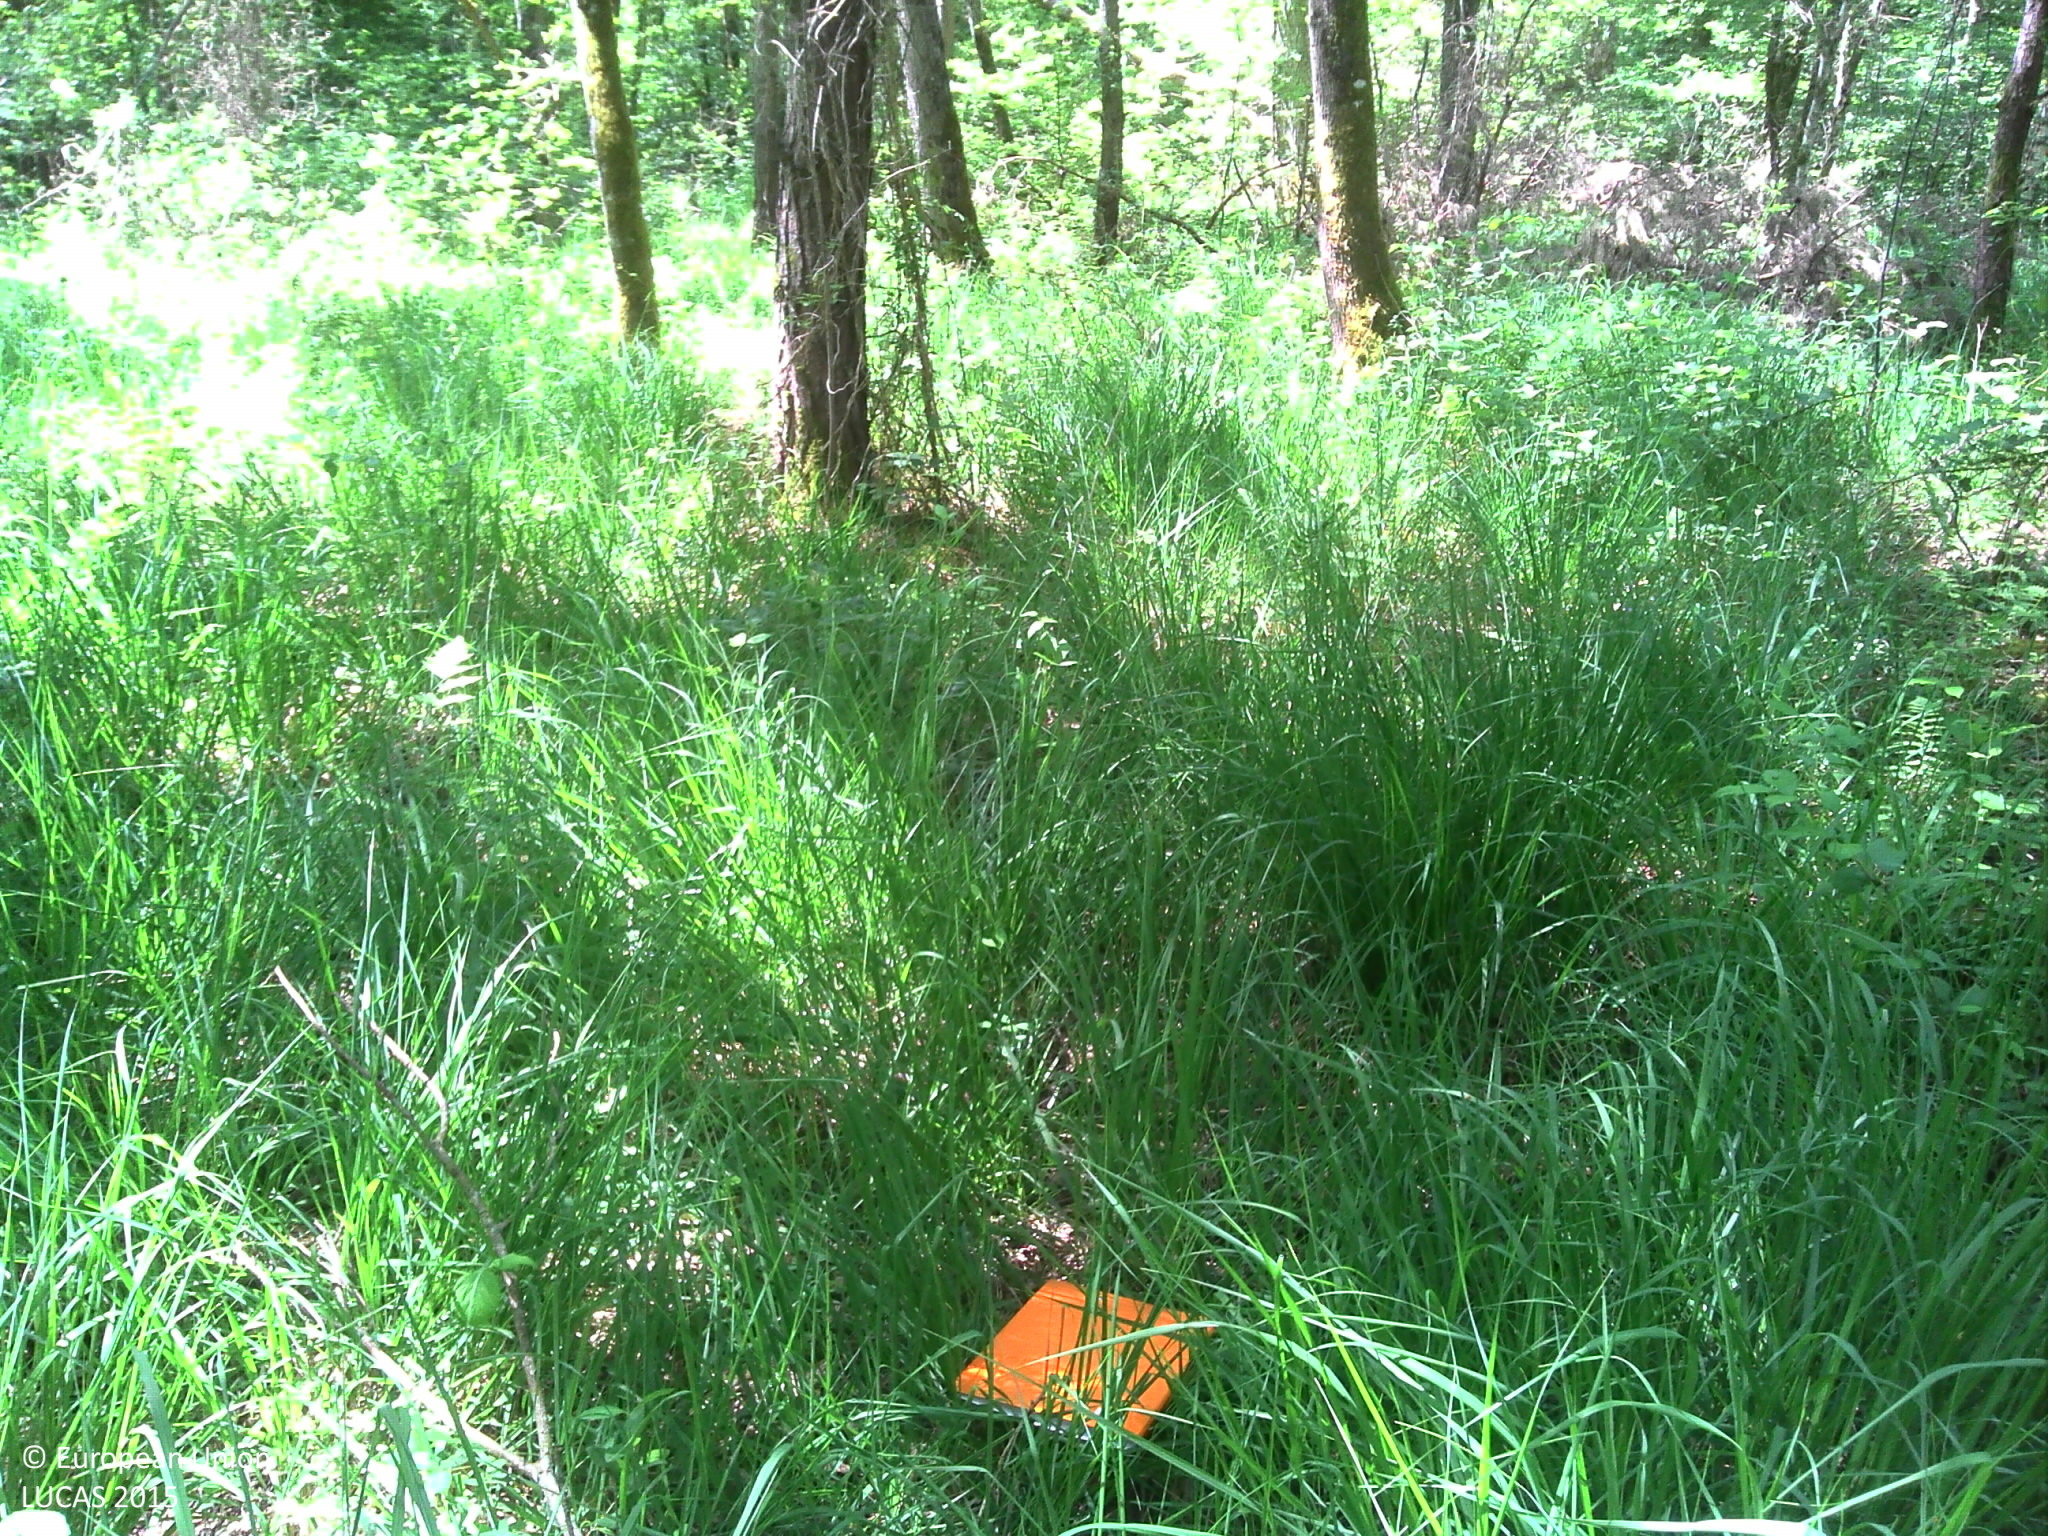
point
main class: Woodland
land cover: Broadleaved woodland
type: thermophilous deciduous forest
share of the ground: > 75 %
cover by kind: broadleaved forest trees 80 %, herbaceous plants 20 %
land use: Forestry
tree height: > 5 m
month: June
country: FR
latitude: 46.6201
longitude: 4.7648
